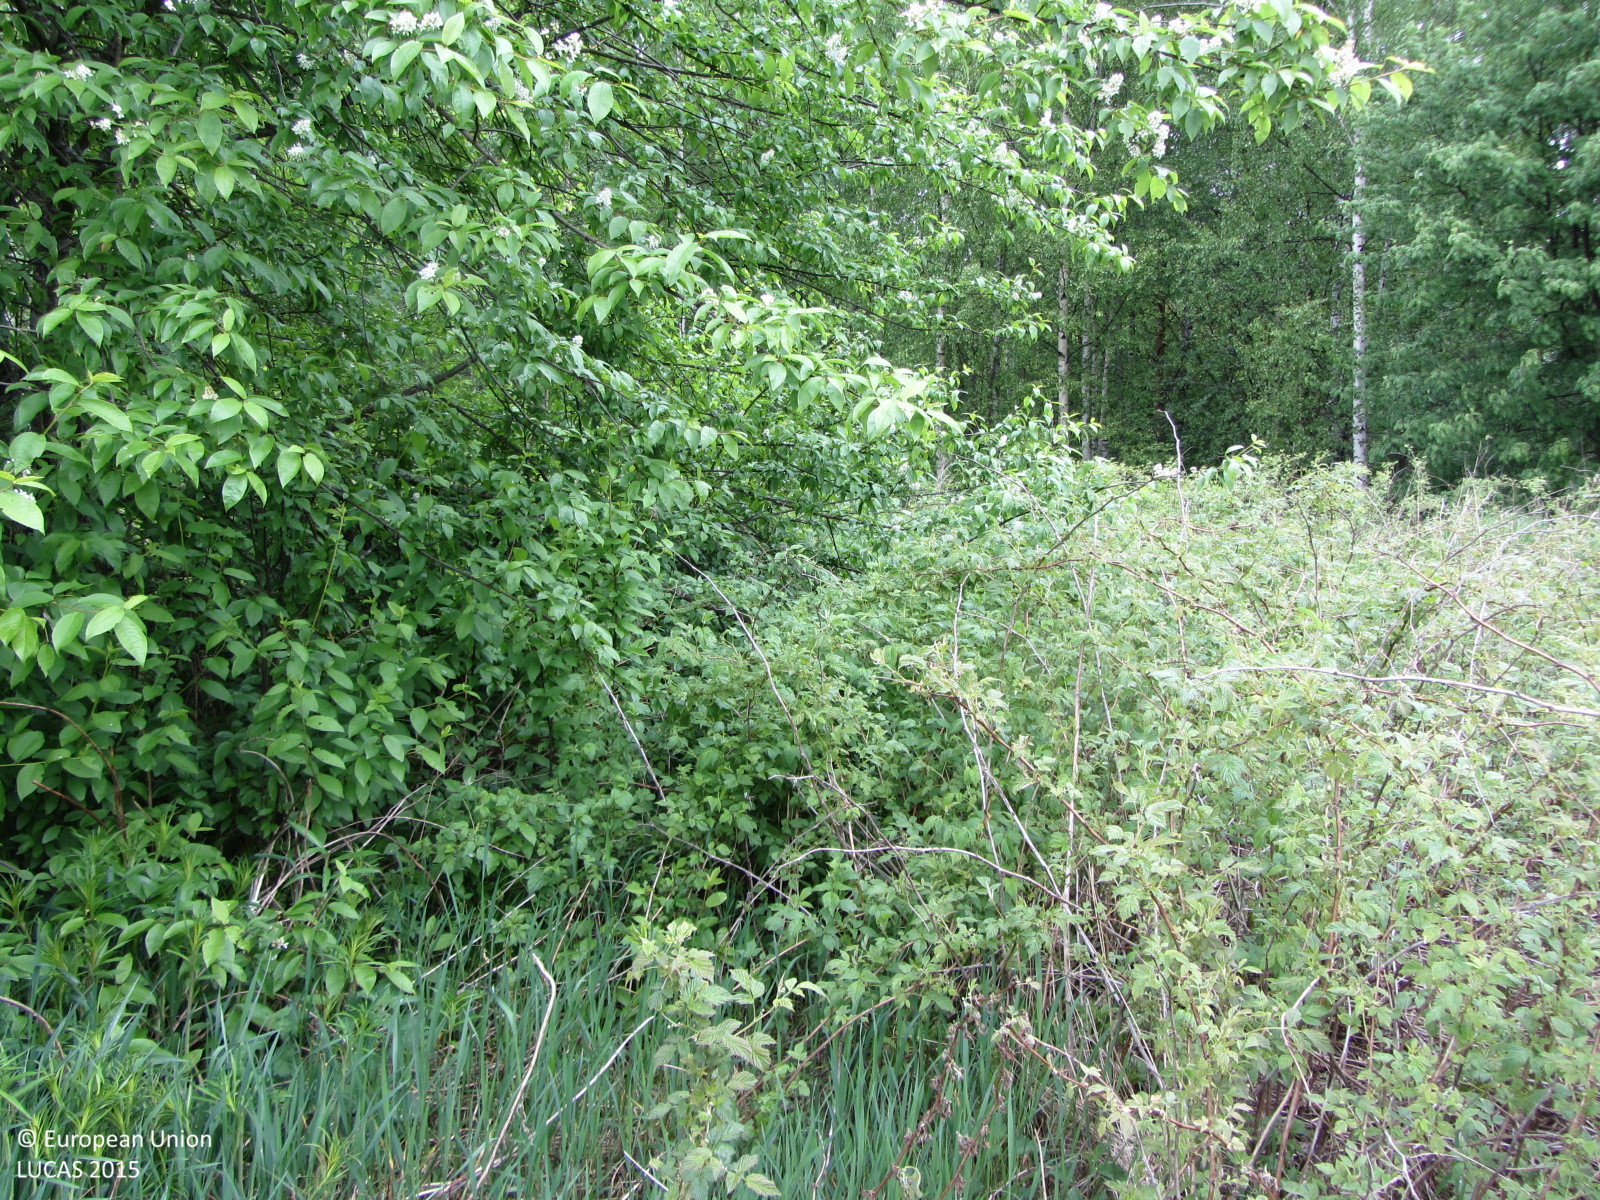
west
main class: Grassland
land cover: Grassland with sparse tree/shrub cover
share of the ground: > 75 %
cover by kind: herbaceous plants 85 %, shrubs 10 %, broadleaved forest trees 5 %
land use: Semi-natural and natural areas not in use
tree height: < 5 m
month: June
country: FI
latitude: 60.1860
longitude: 24.7742
